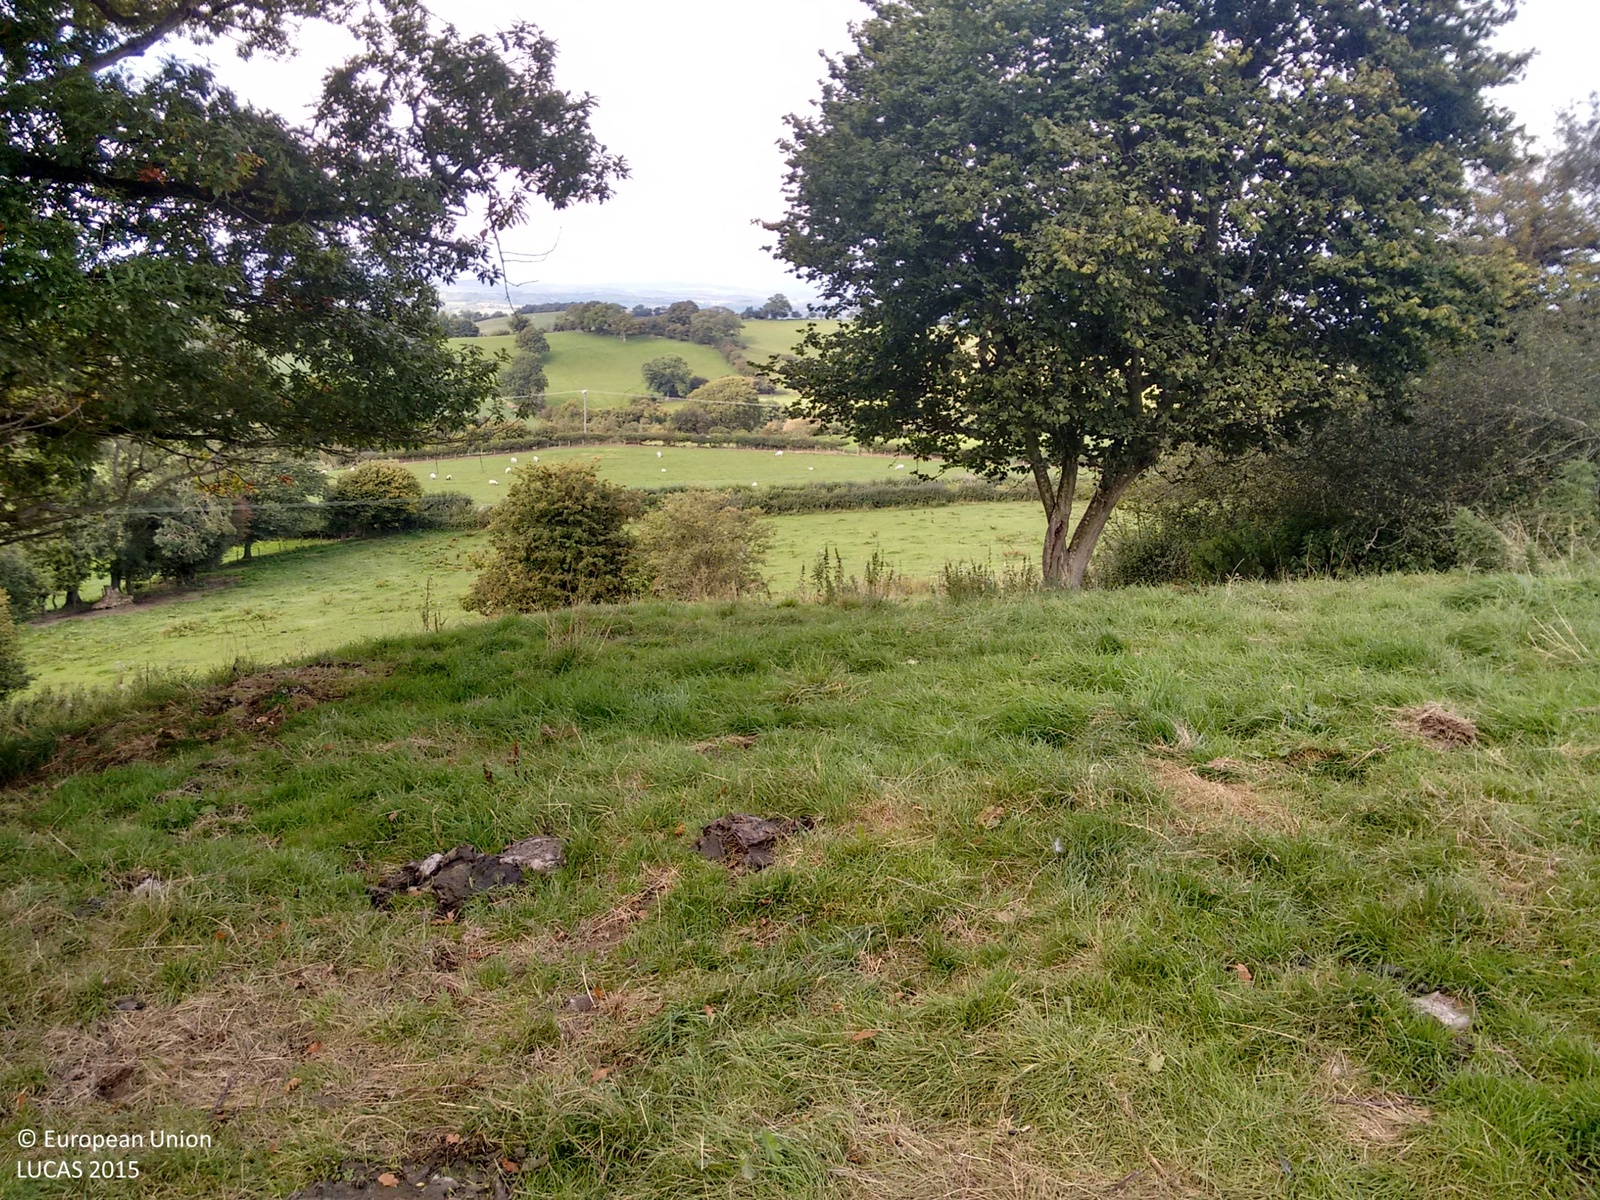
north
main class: Grassland
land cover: Grassland without tree/shrub cover
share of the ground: > 75 %
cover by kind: herbaceous plants 100 %
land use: Agriculture (excluding fallow land and kitchen gardens)
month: September
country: GB
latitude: 52.6448
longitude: -3.3082
